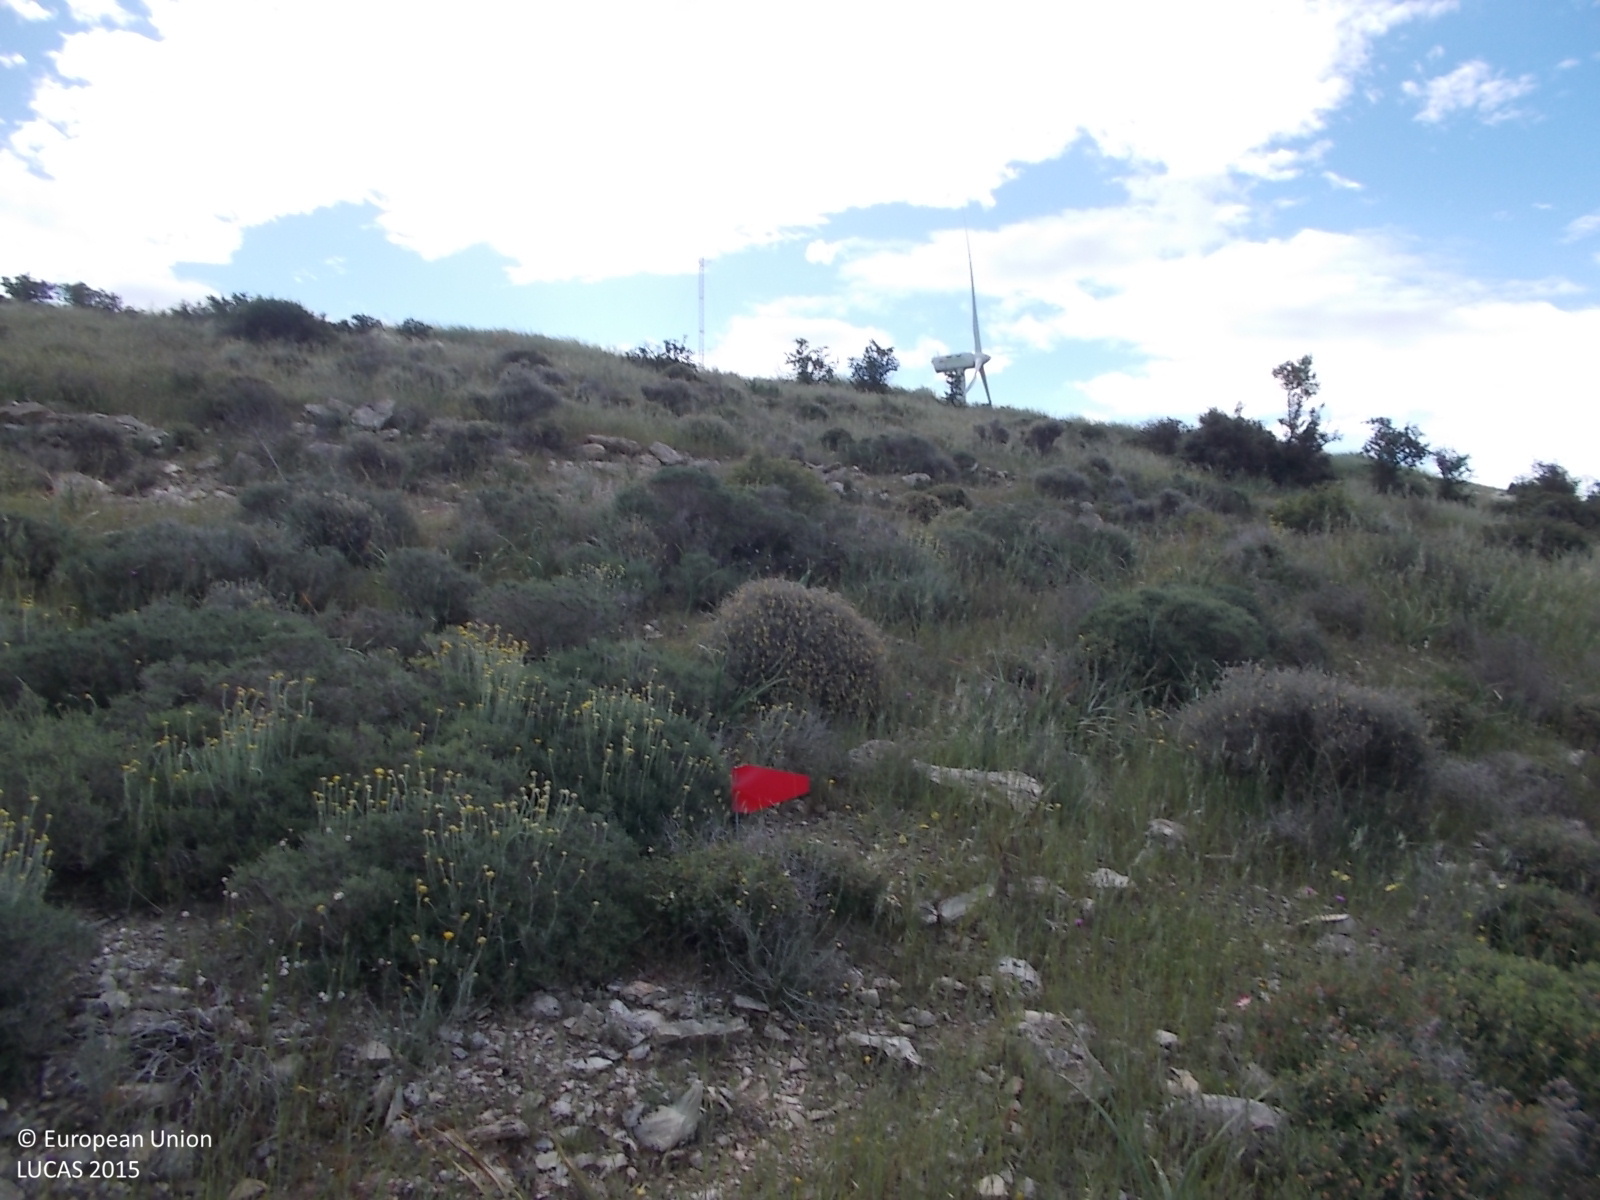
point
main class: Shrubland
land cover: Shrubland without tree cover
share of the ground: 50 - 75 %
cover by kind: shrubs 60 %, unconsolidated bare surface 30 %, herbaceous plants 10 %
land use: Semi-natural and natural areas not in use
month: April
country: CY
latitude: 34.9680
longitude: 33.4883
